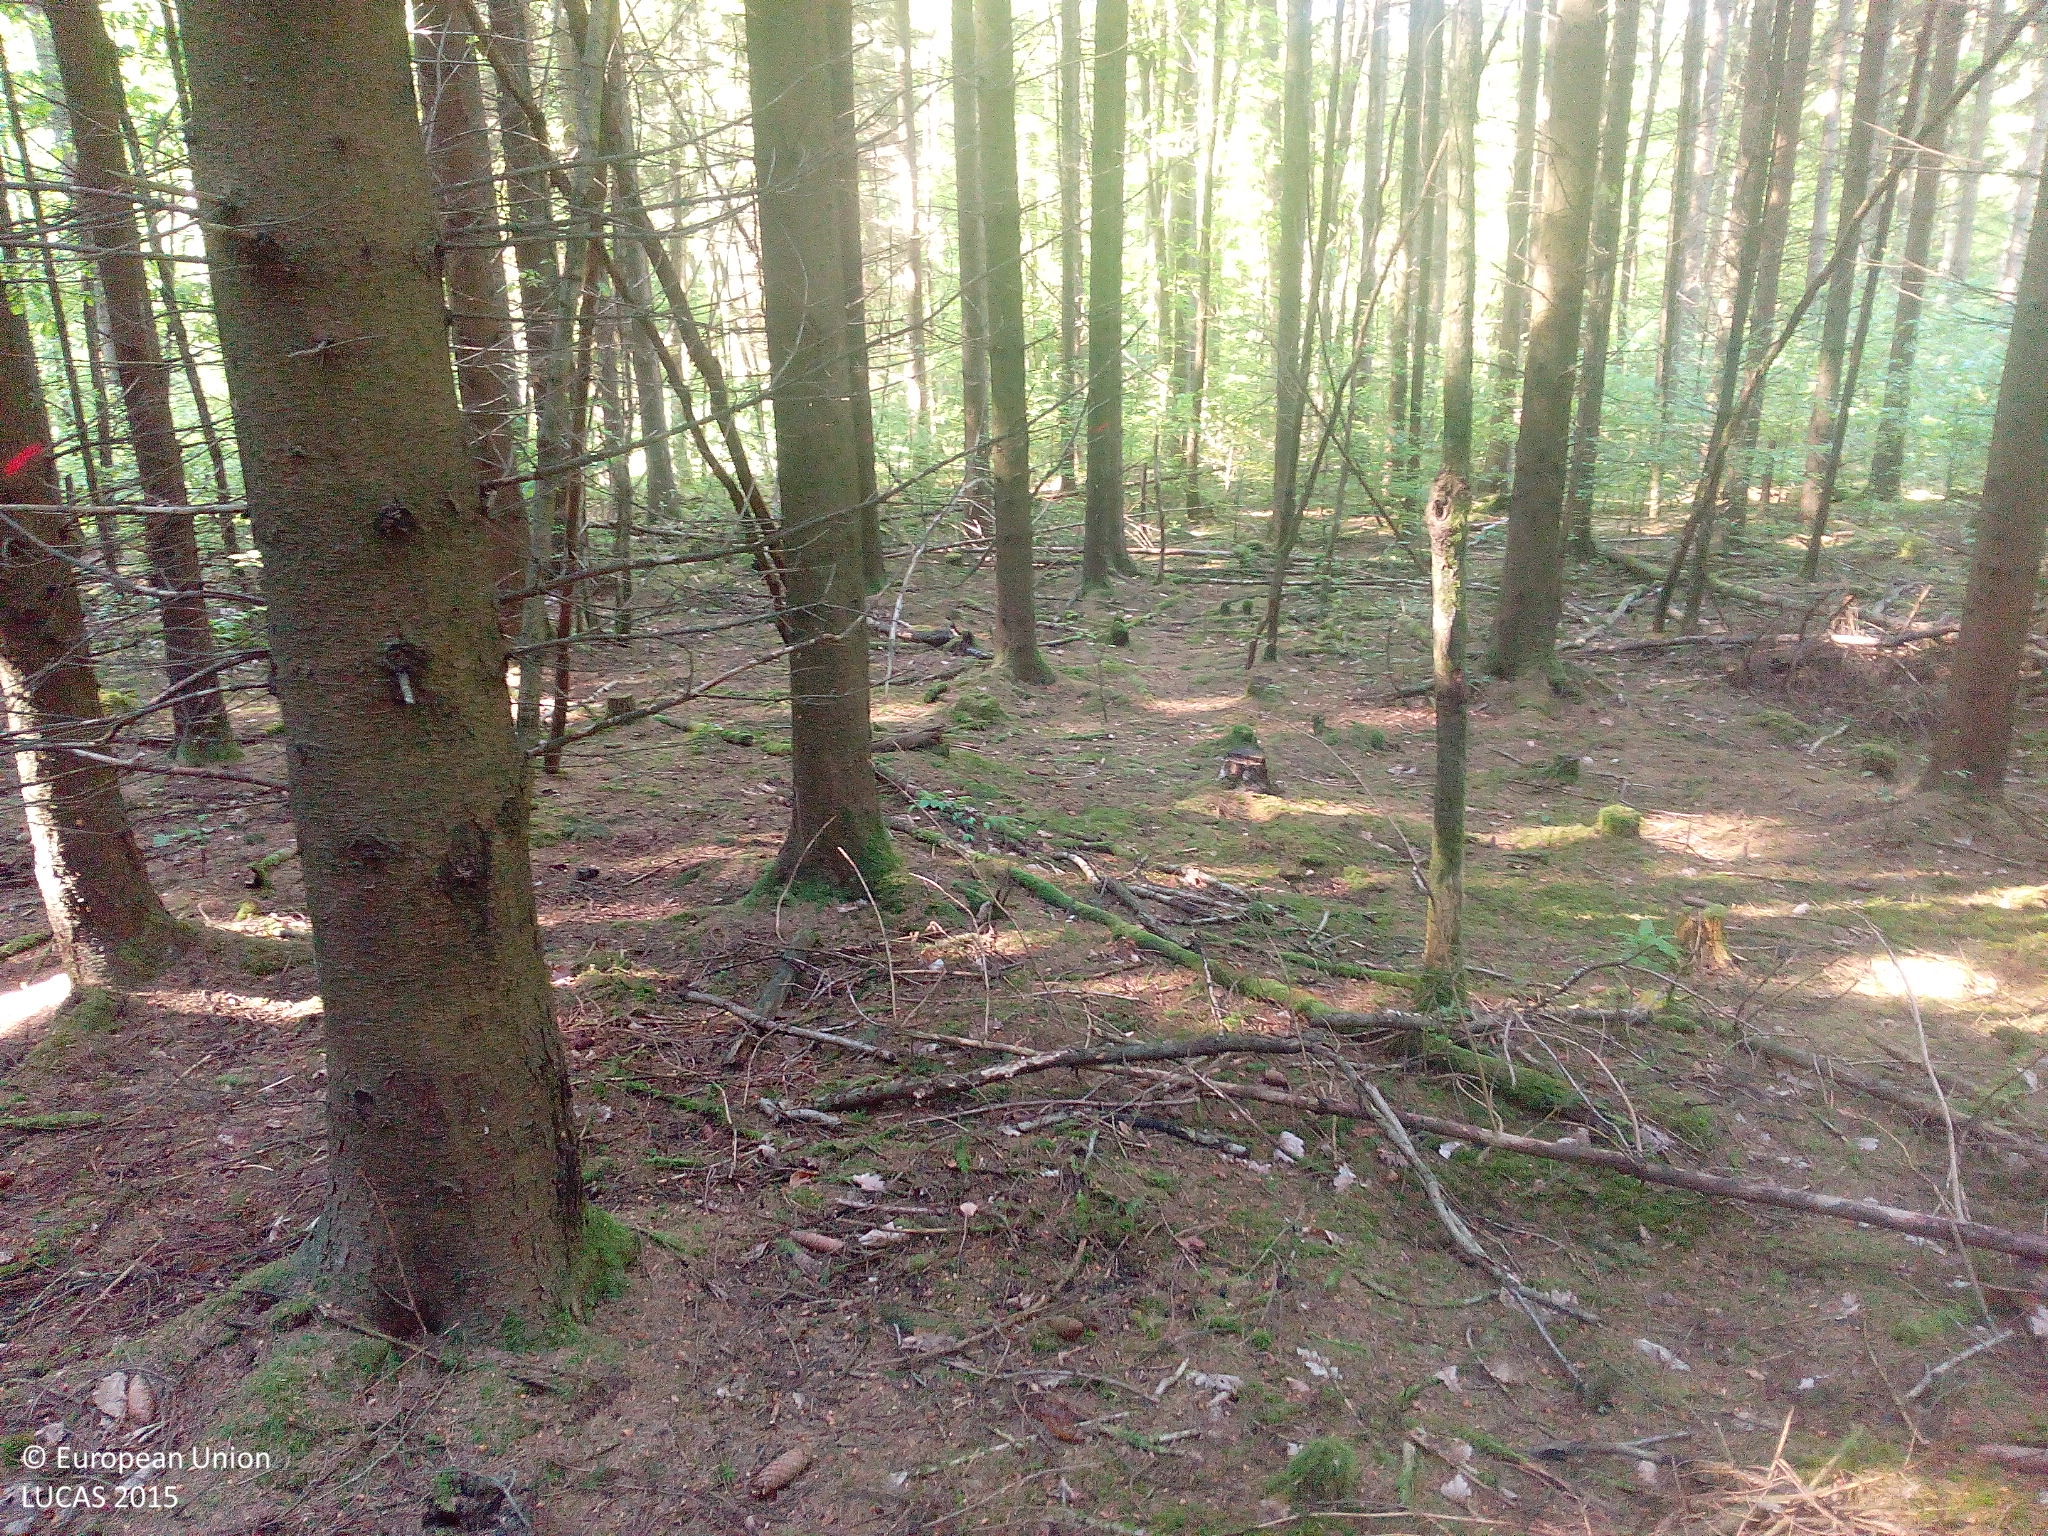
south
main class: Woodland
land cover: Spruce dominated coniferous woodland
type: hemiboreal forest and nemoral coniferous forest and mixed broadleaved-coniferous forest
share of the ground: > 75 %
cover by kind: coniferous forest trees 100 %
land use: Forestry
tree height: > 5 m
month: May
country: DE
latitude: 49.9826
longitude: 10.9341
